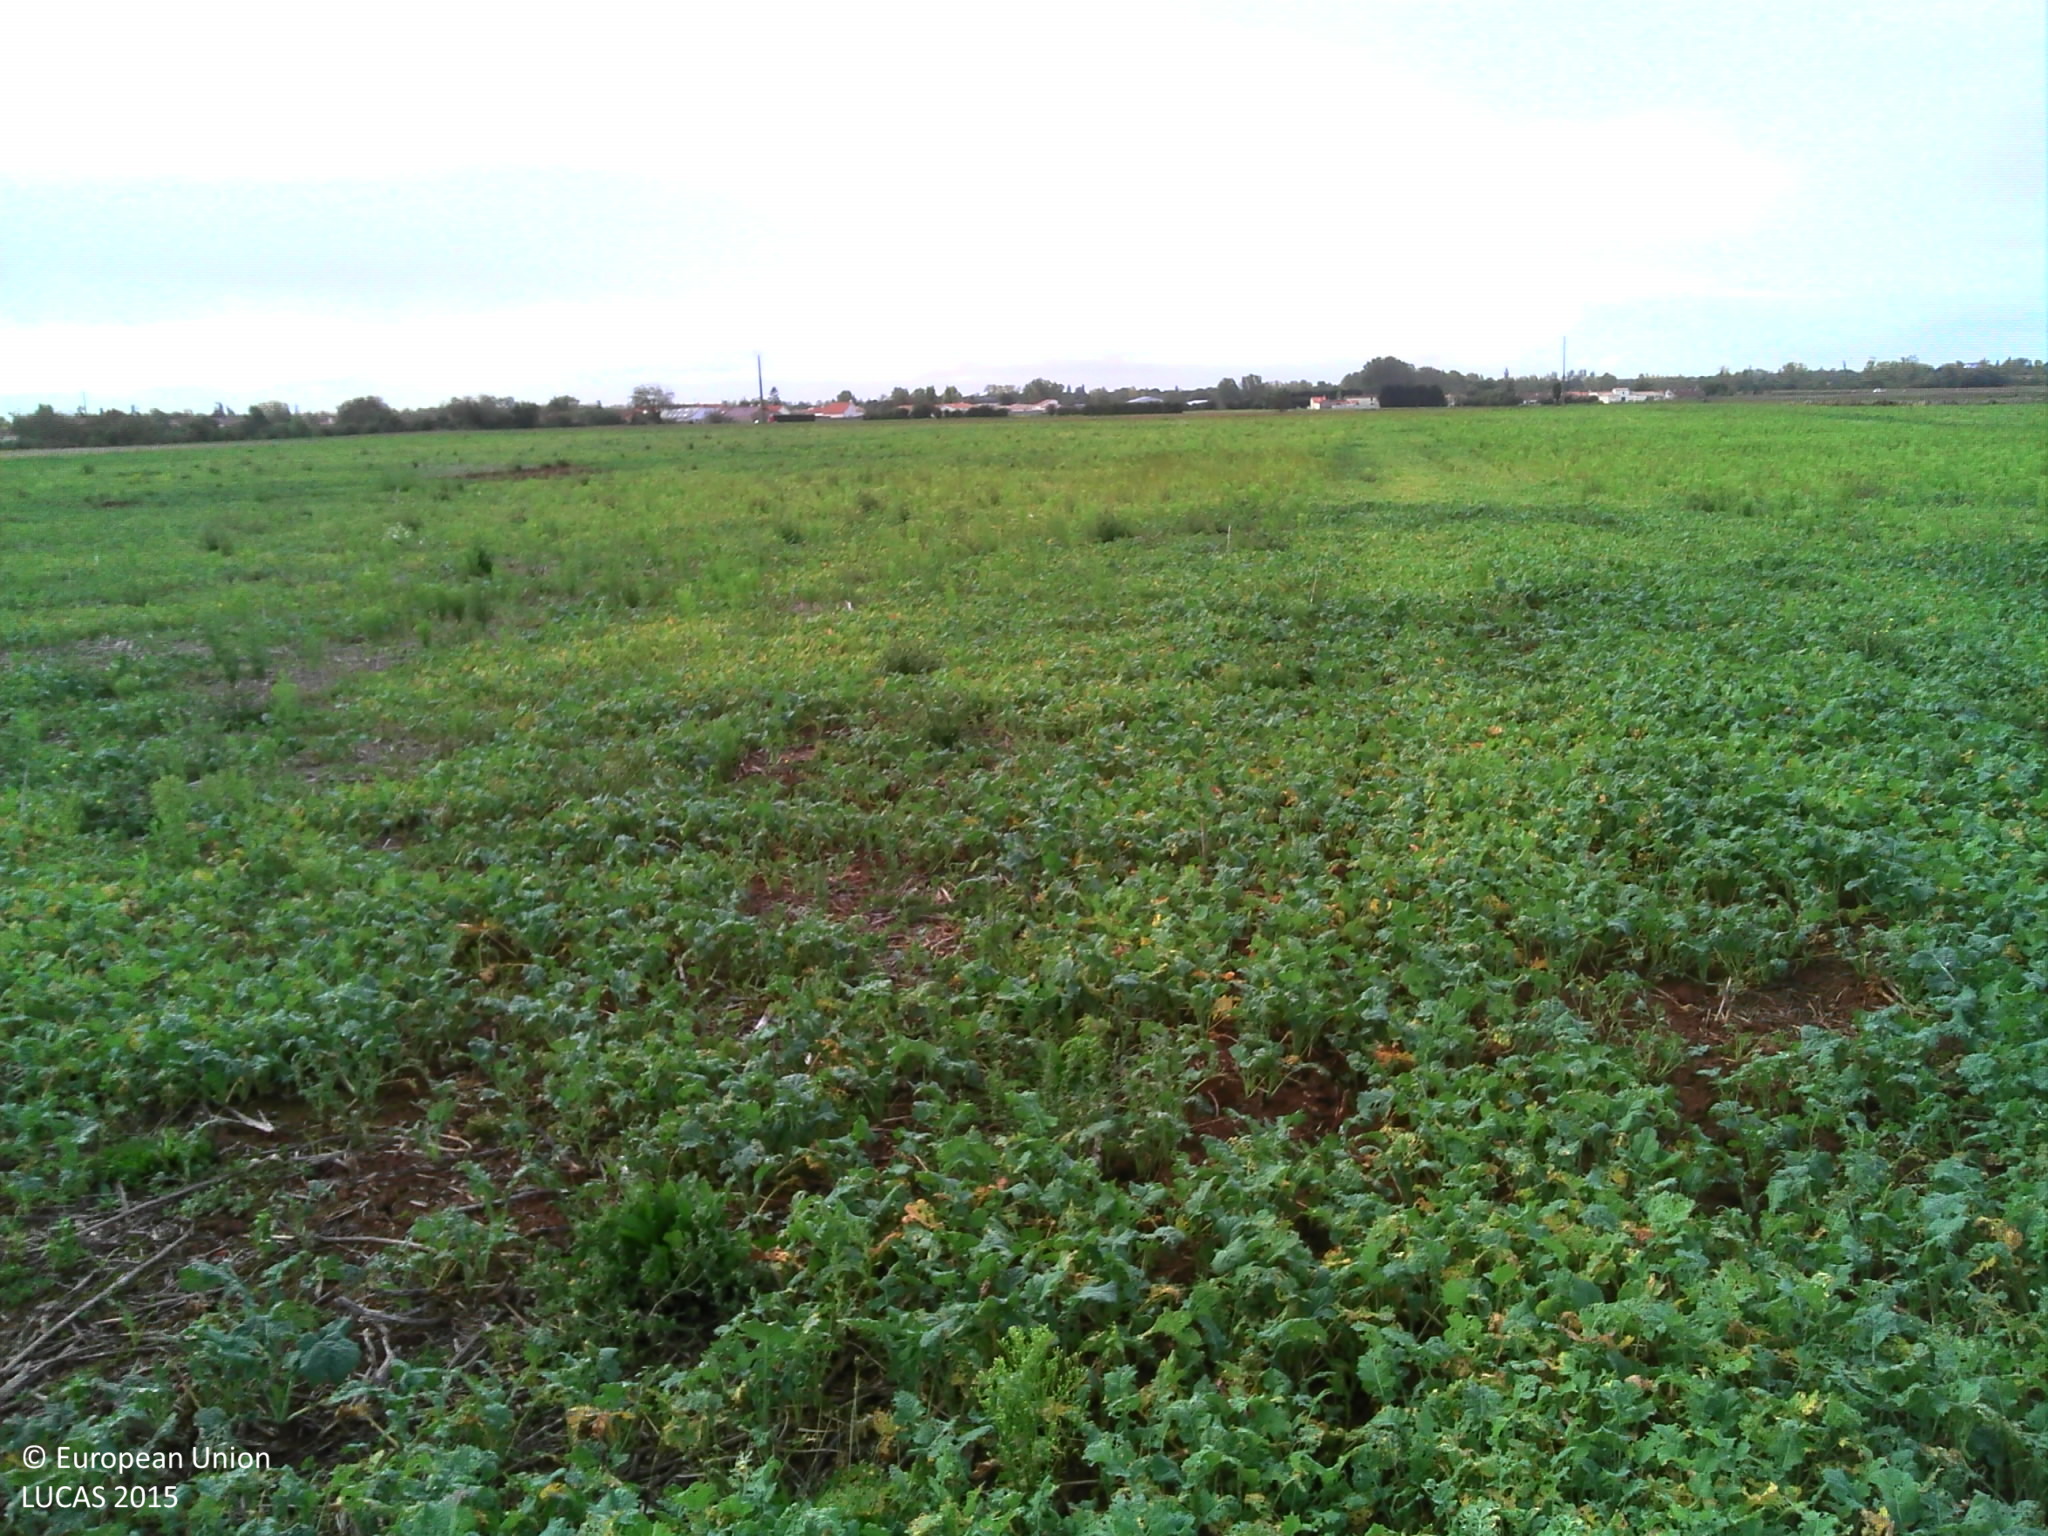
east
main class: Cropland
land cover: Rape and turnip rape
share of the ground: 50 - 75 %
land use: Agriculture (excluding fallow land and kitchen gardens)
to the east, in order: Rape and turnip rape; Barley
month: October
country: FR
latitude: 46.4839
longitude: -1.0659
